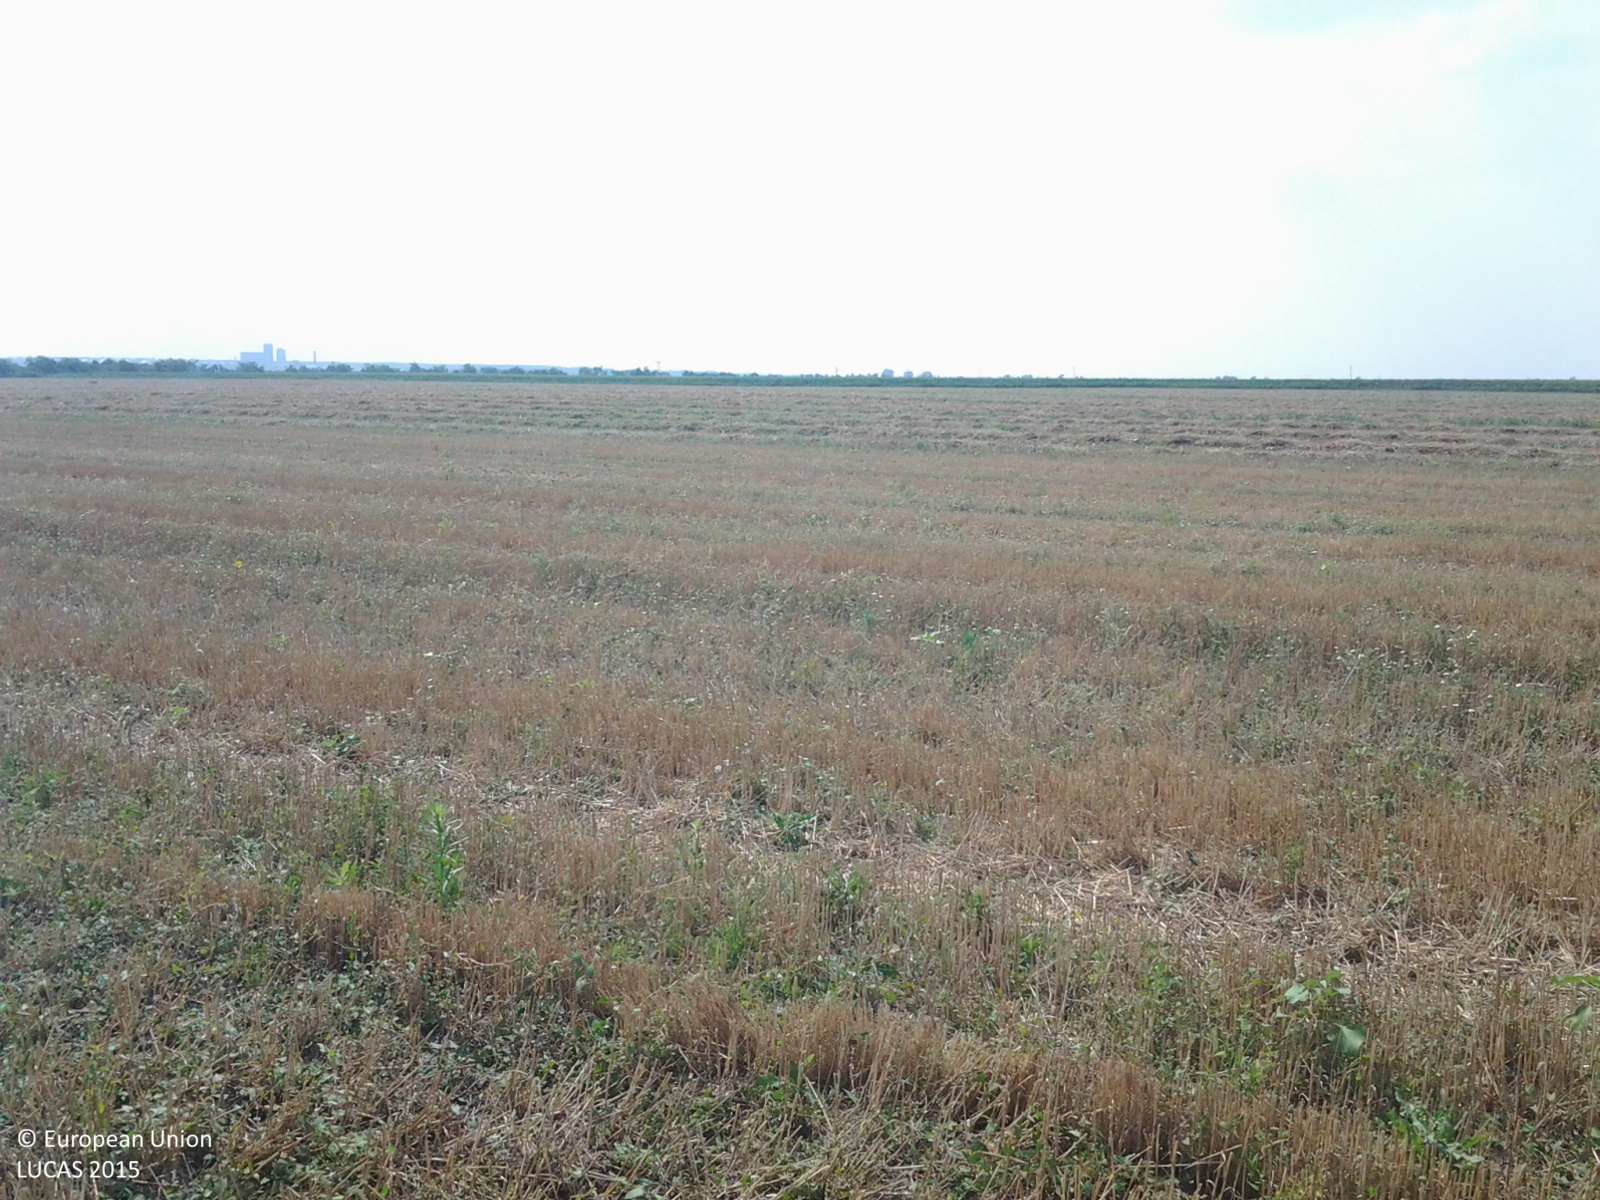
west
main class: Cropland
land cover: Common wheat
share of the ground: 10 - 25 %
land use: Agriculture (excluding fallow land and kitchen gardens)
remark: Harvested field
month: August
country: HU
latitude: 47.0472
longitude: 20.3337
